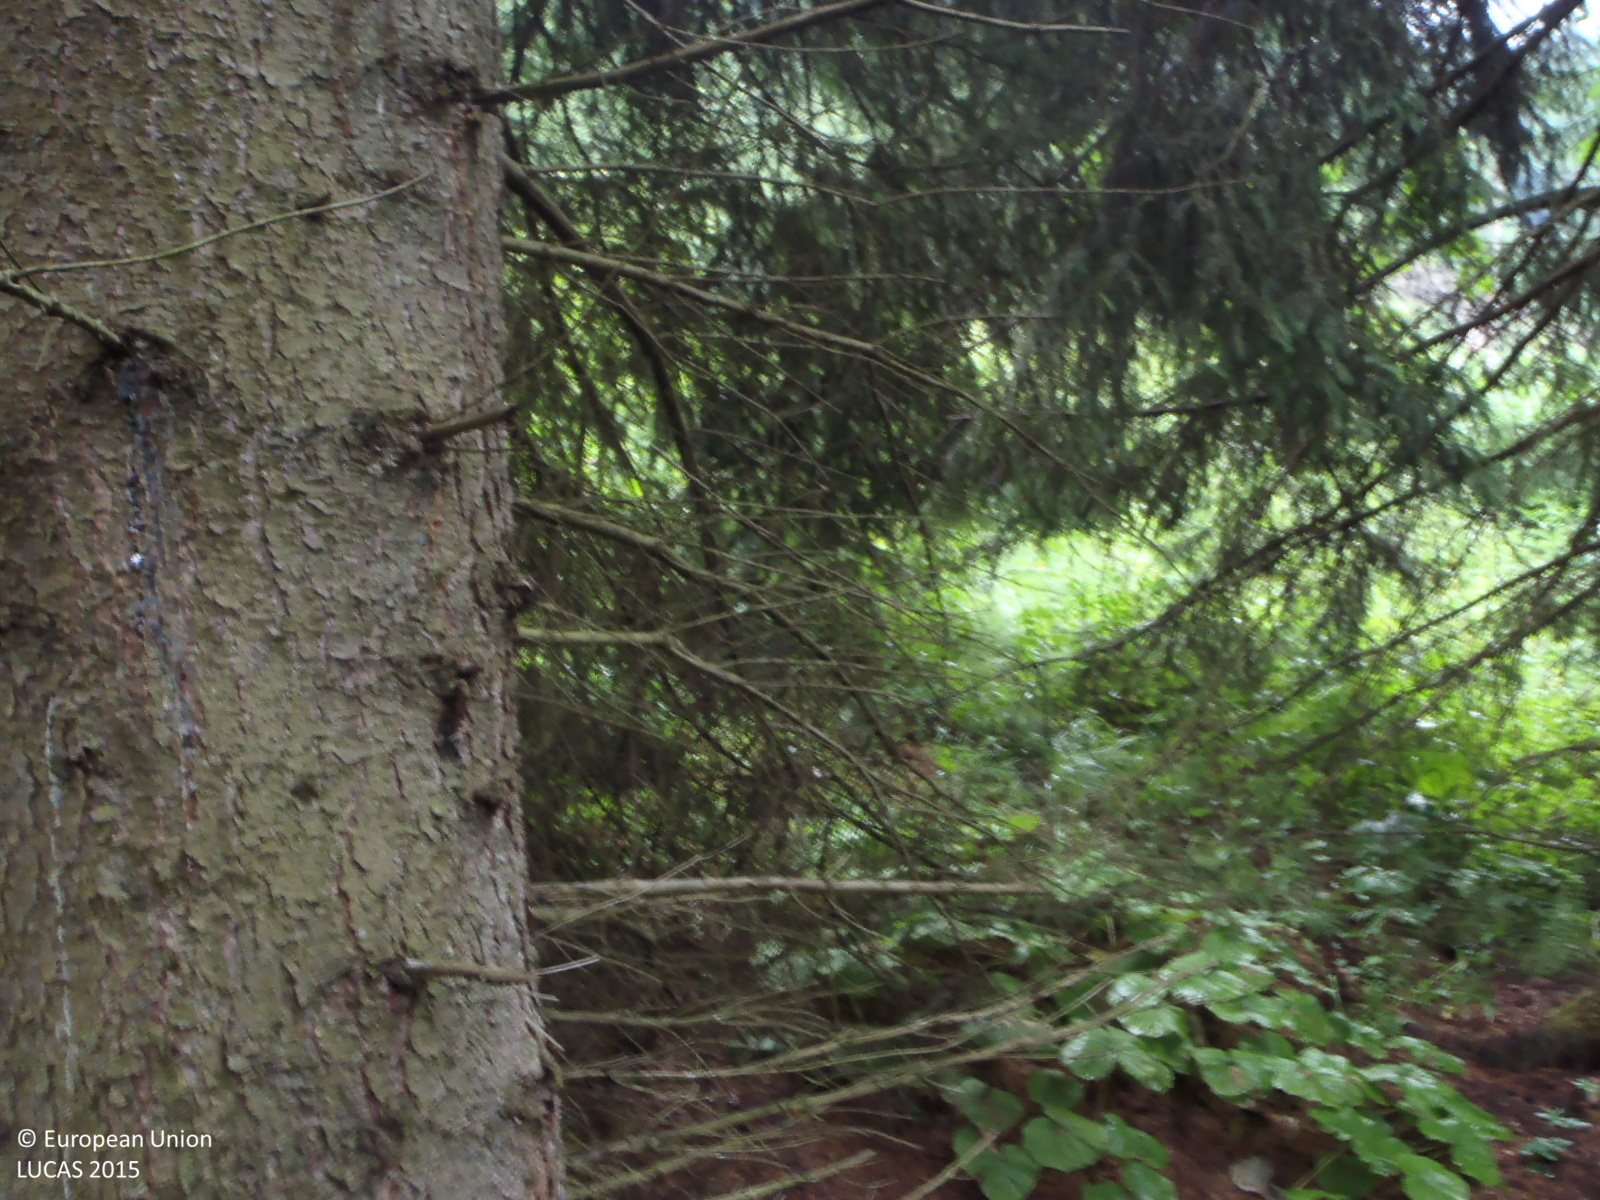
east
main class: Woodland
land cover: Spruce dominated coniferous woodland
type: alpine coniferous forest
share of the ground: > 75 %
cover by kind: coniferous forest trees 80 %, broadleaved forest trees 20 %
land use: Forestry
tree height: > 5 m
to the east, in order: Spruce dominated coniferous woodland; Shruby margins; Electric lines; Railways; Electric lines; Other bare soil; Rocks and stones; Grassland without tree/shrub cover; Broadleaved woodland; Spruce dominated mixed woodland; Spruce dominated coniferous woodland; Tracks; Shrubland without tree cover
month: July
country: AT
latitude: 47.4277
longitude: 12.1858
